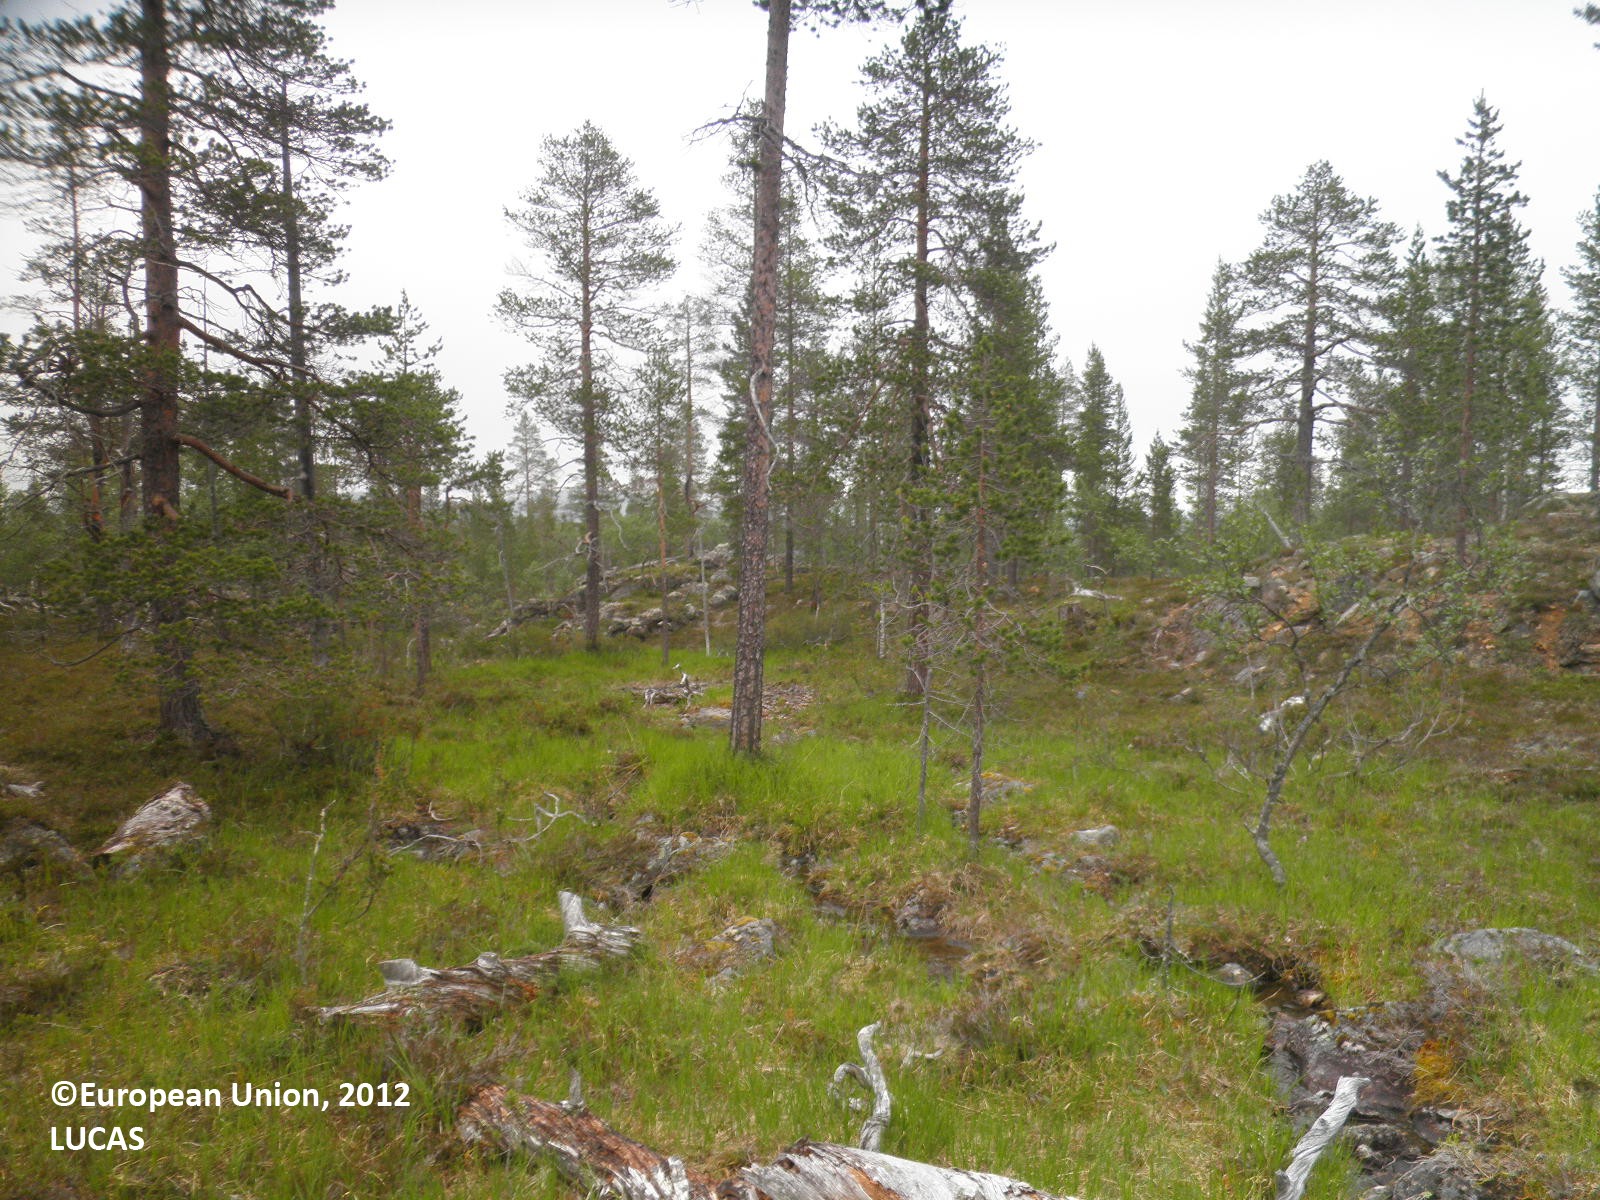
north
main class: Woodland
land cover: Pine dominated mixed woodland
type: boreal forest
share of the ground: 10 - 25 %
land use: Semi-natural and natural areas not in use
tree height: > 5 m
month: July
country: FI
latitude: 68.5411
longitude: 27.7463
